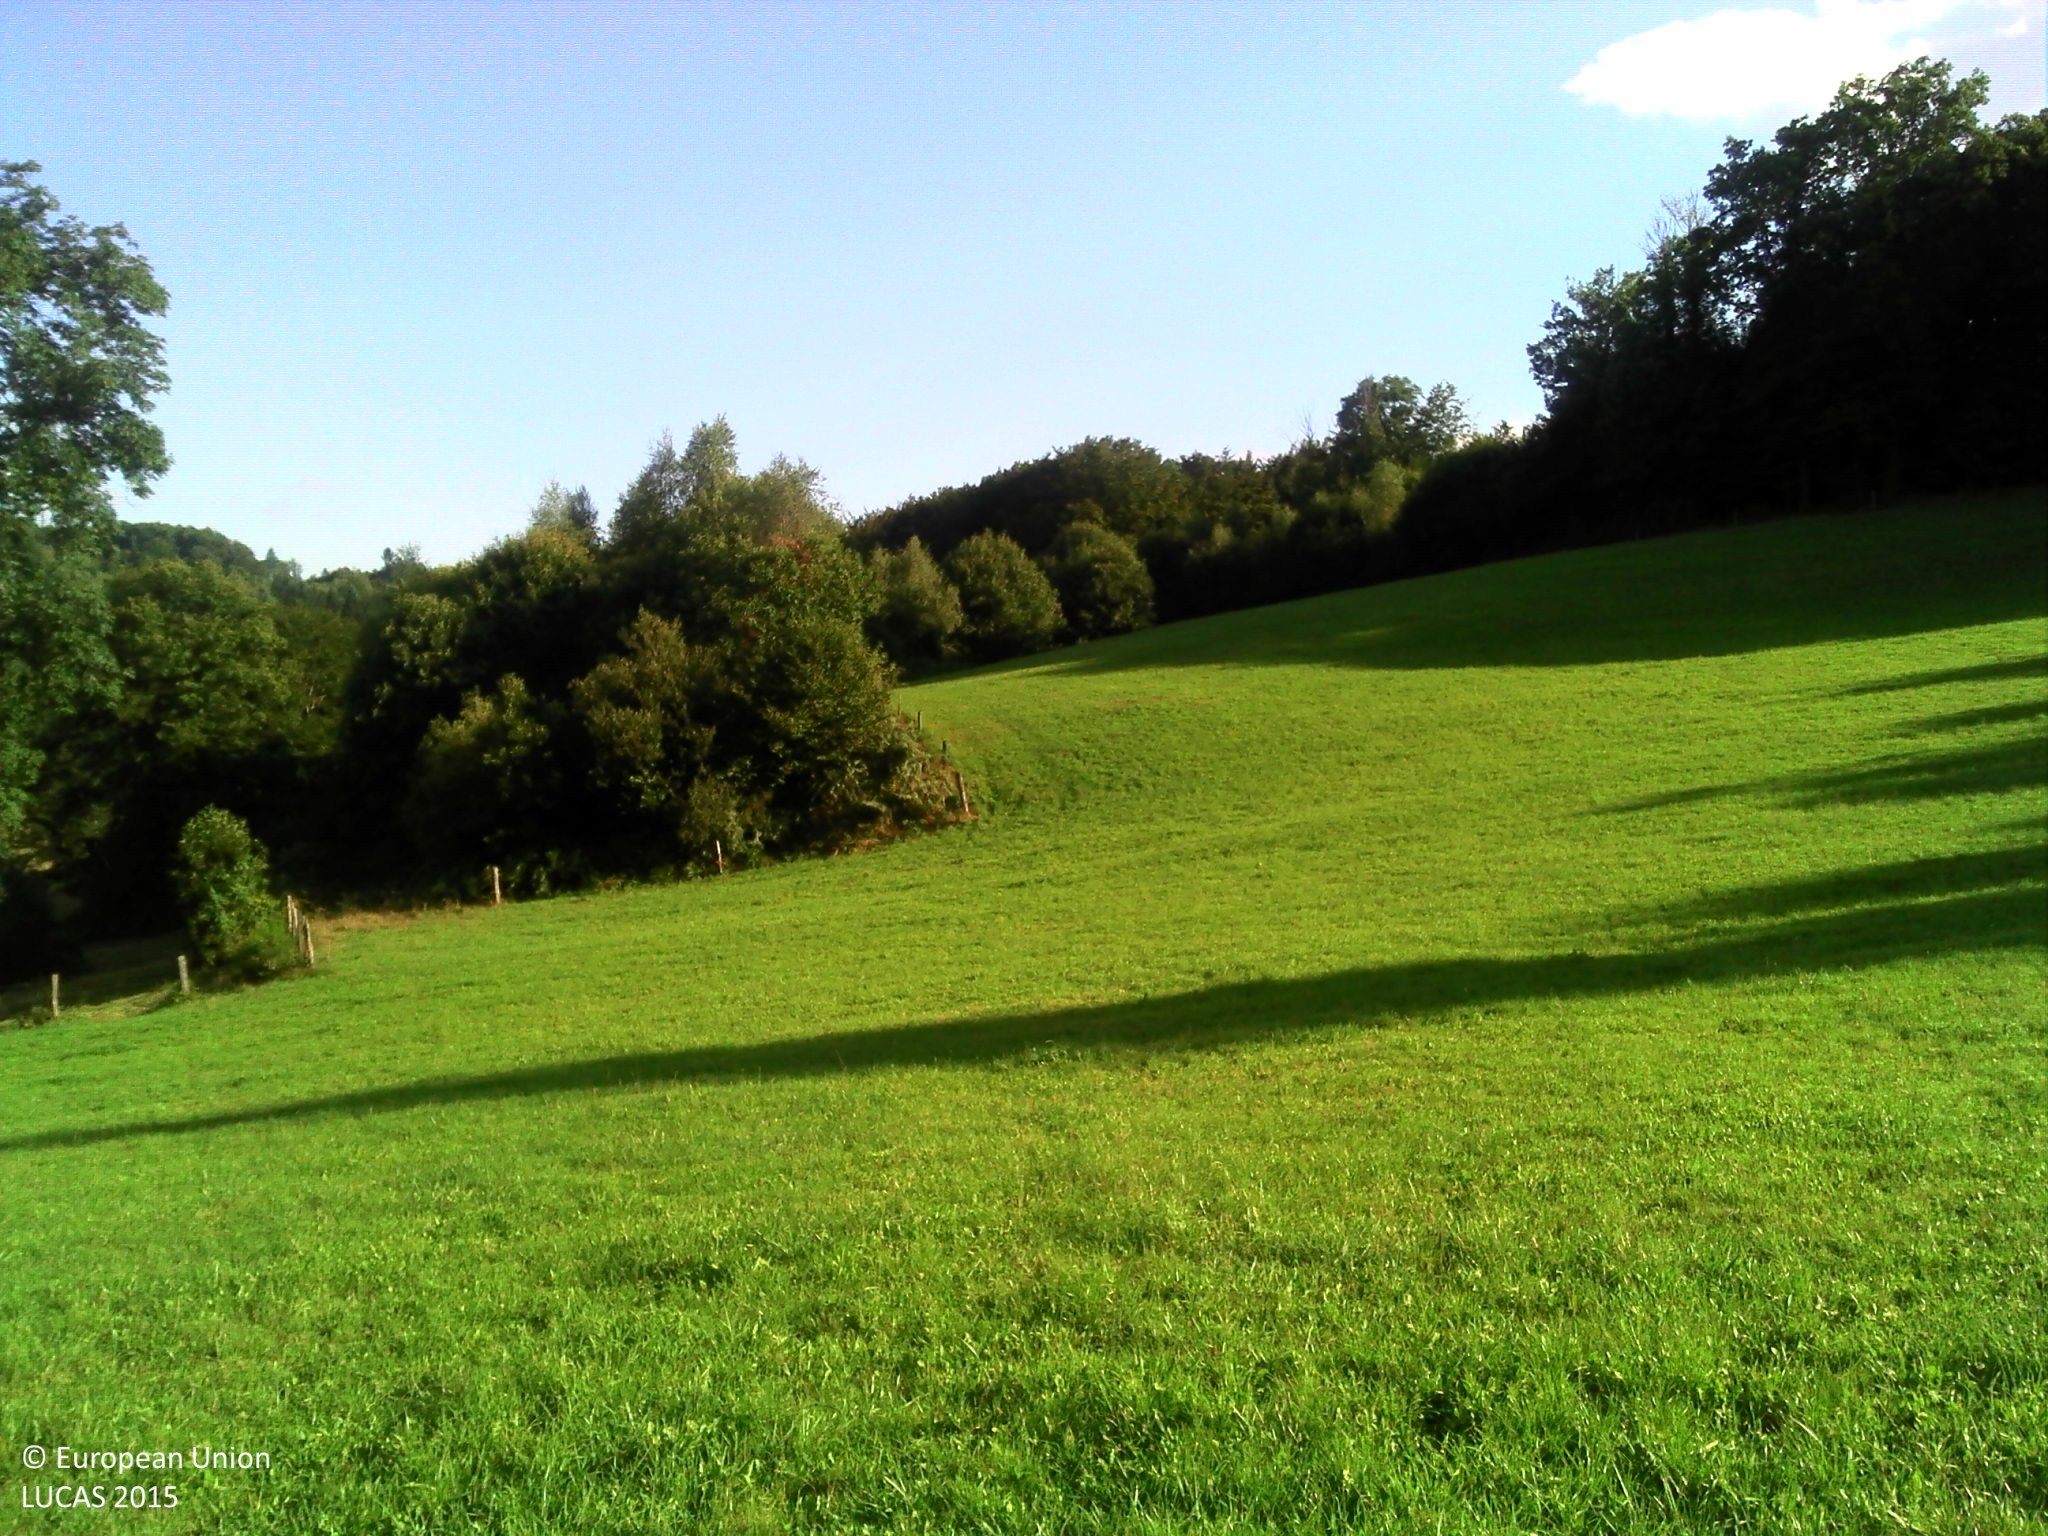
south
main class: Grassland
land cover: Grassland without tree/shrub cover
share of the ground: > 75 %
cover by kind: herbaceous plants 100 %
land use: Agriculture (excluding fallow land and kitchen gardens)
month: August
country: FR
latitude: 45.9019
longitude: 1.7051
